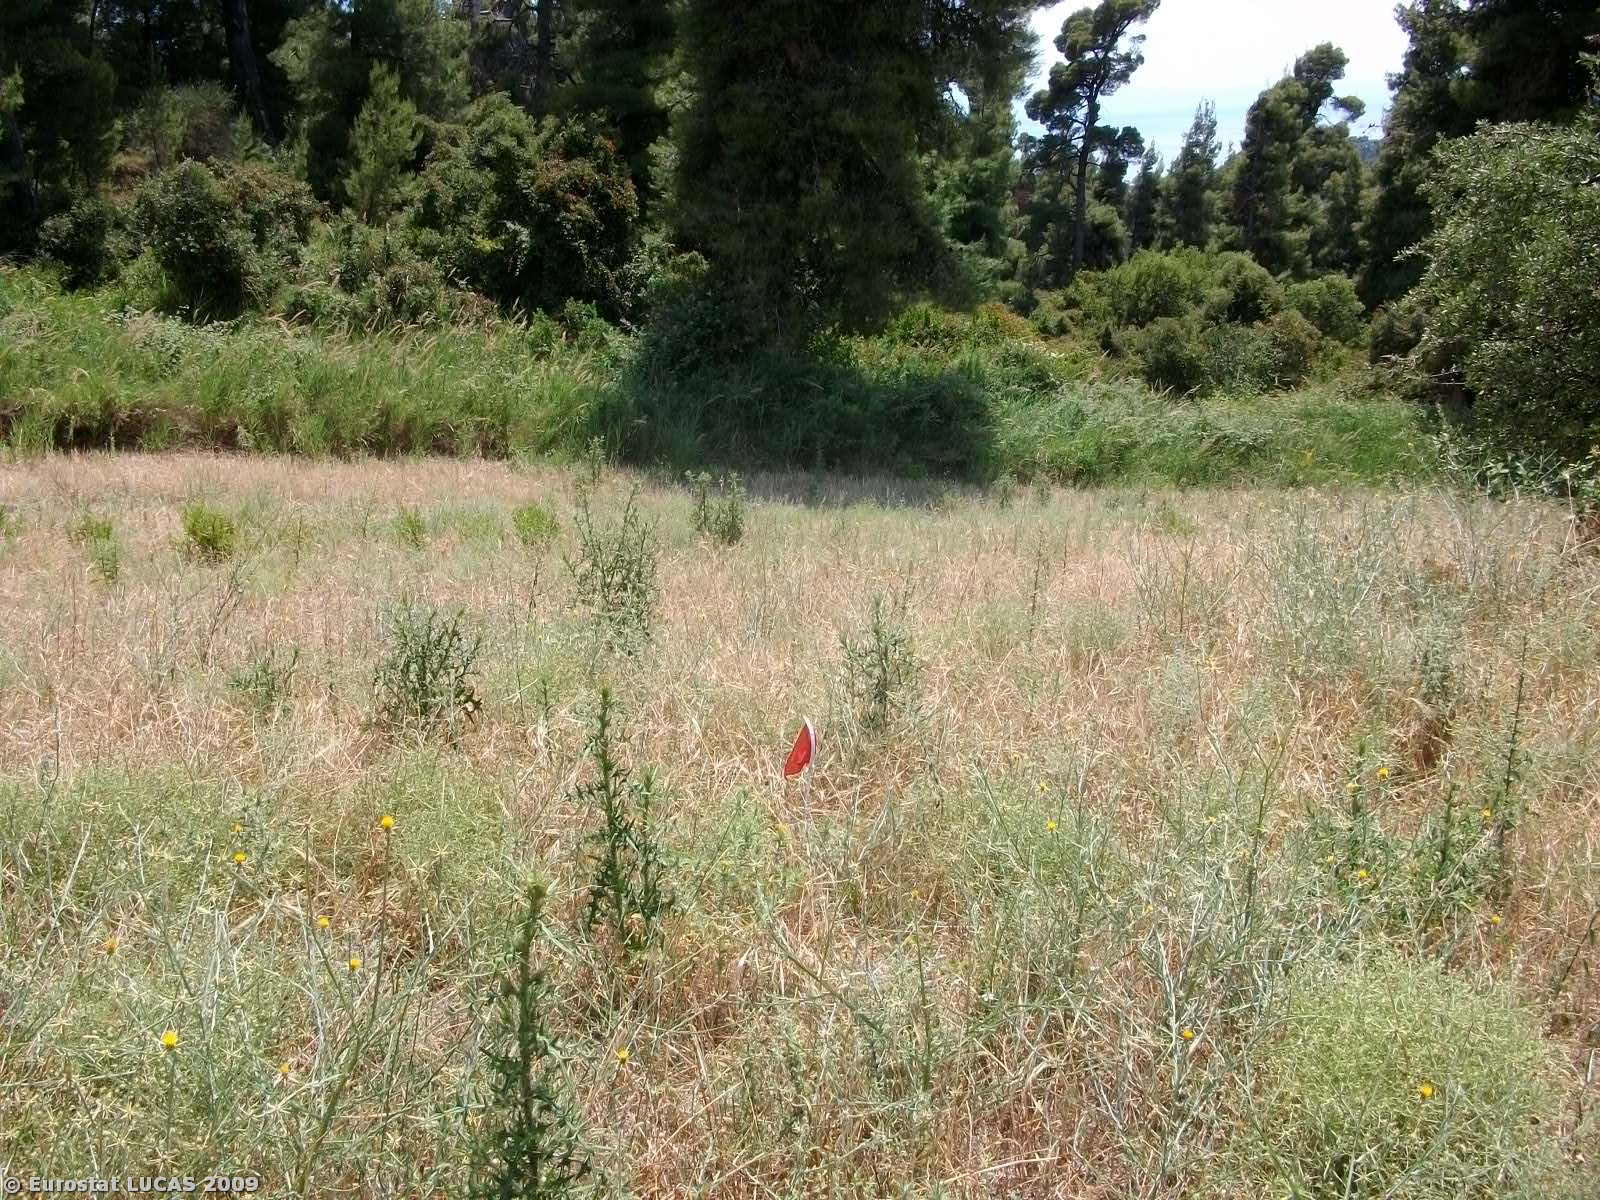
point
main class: Grassland
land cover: Grassland without tree/shrub cover
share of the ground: > 75 %
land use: Agriculture (excluding fallow land and kitchen gardens)
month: June
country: GR
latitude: 39.9795
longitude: 23.4361
